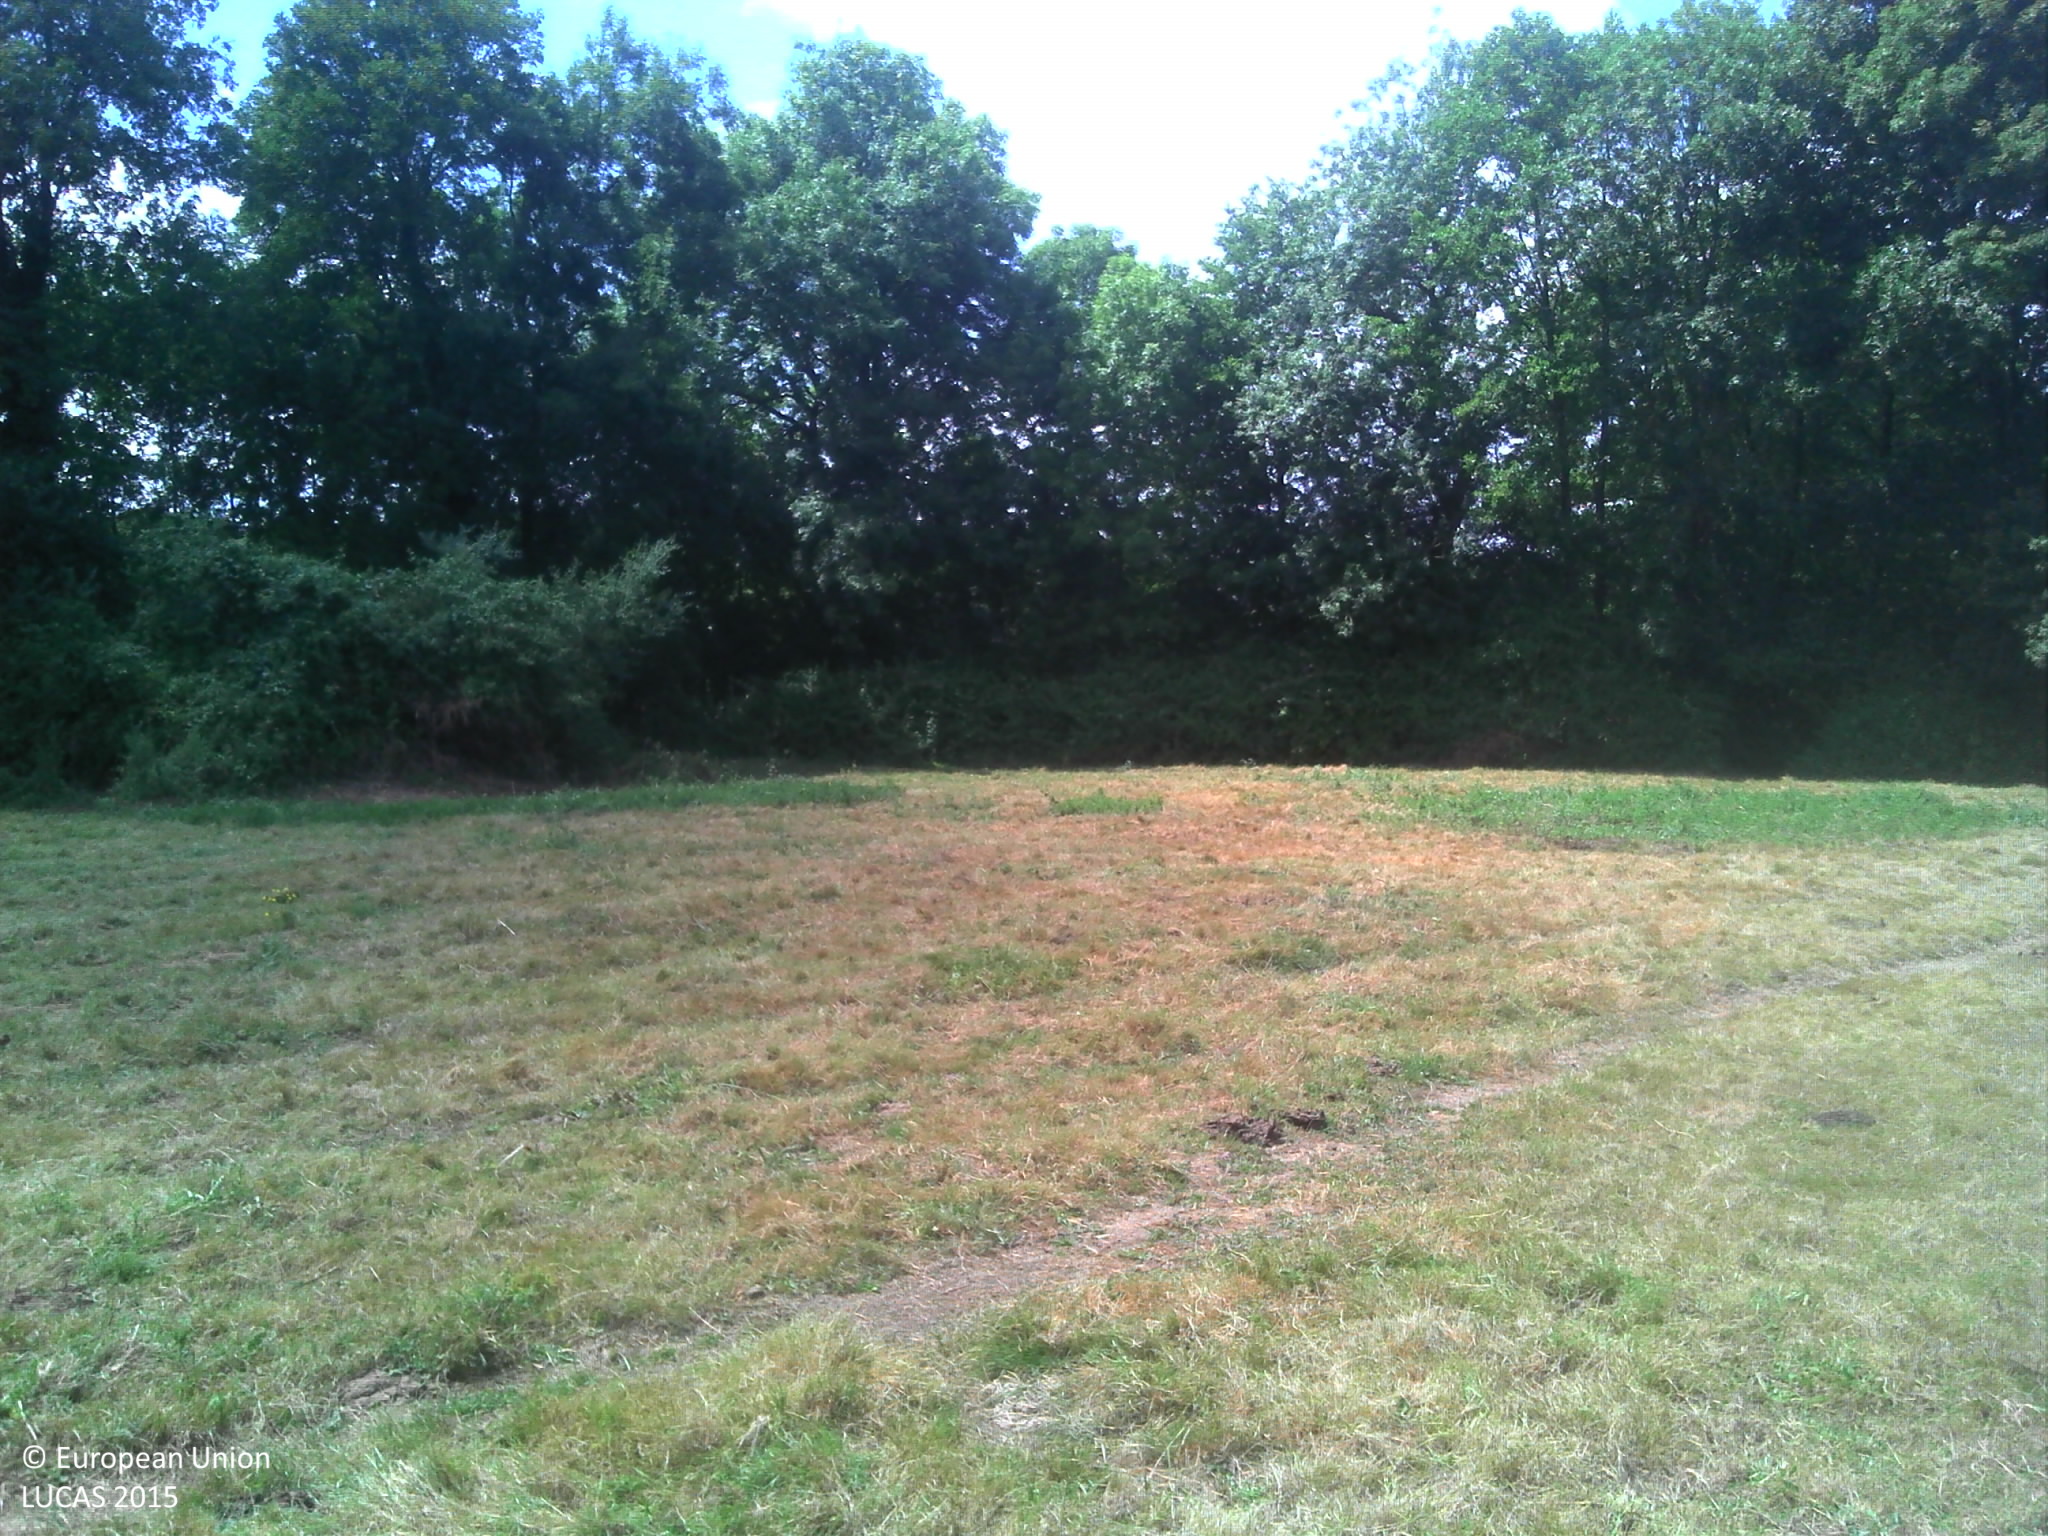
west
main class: Grassland
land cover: Grassland without tree/shrub cover
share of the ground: > 75 %
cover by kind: herbaceous plants 100 %
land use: Agriculture (excluding fallow land and kitchen gardens)
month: July
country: FR
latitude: 46.5074
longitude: -1.3609
